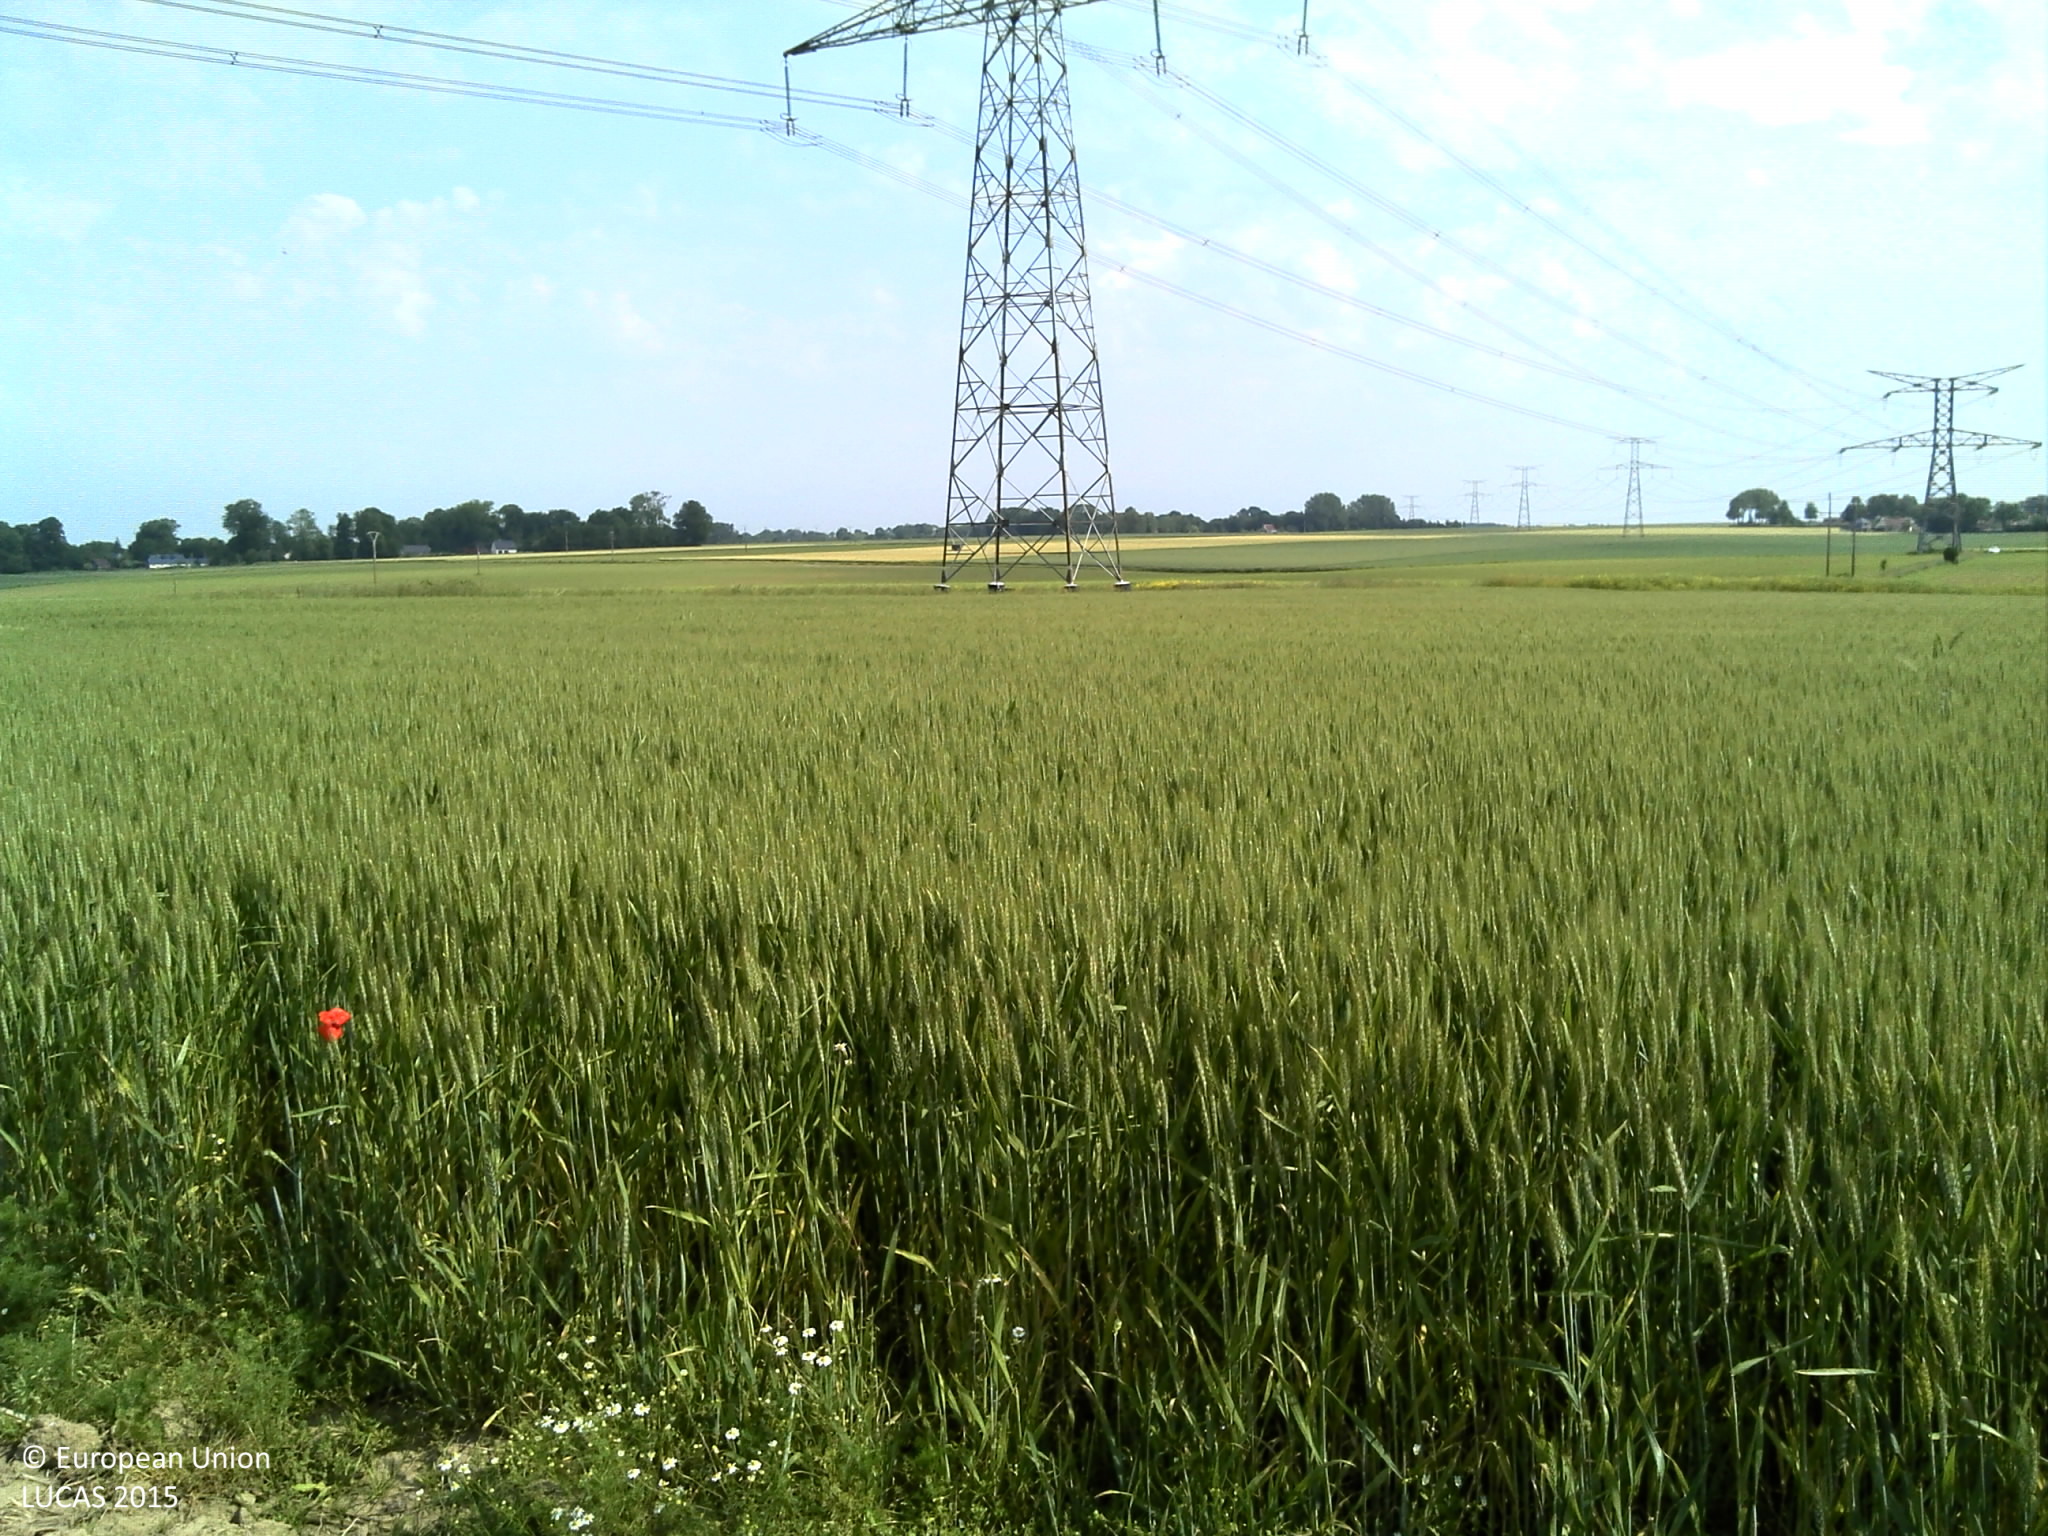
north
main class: Cropland
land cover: Maize
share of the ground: 10 - 25 %
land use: Agriculture (excluding fallow land and kitchen gardens)
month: June
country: FR
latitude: 49.7438
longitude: 1.0828
